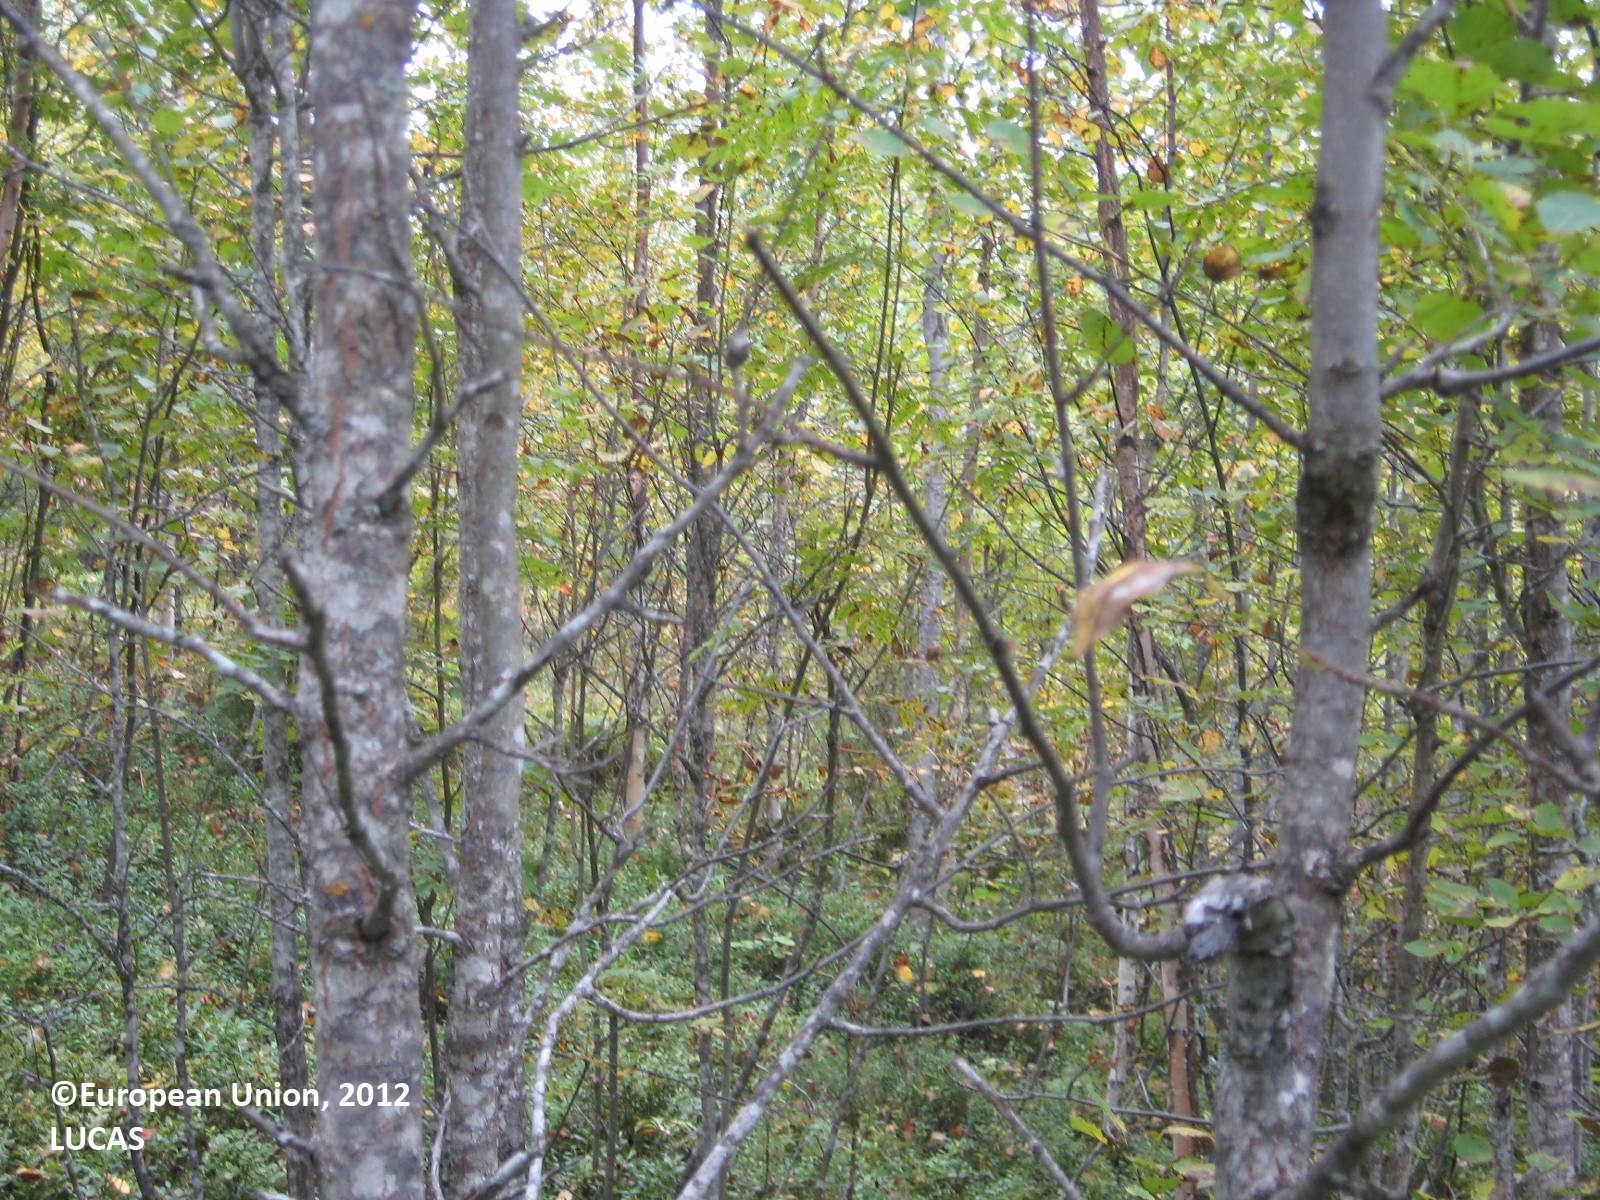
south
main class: Woodland
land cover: Broadleaved woodland
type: boreal forest
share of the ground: > 75 %
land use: Forestry
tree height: > 5 m
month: September
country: FI
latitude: 64.0209
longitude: 28.1983
